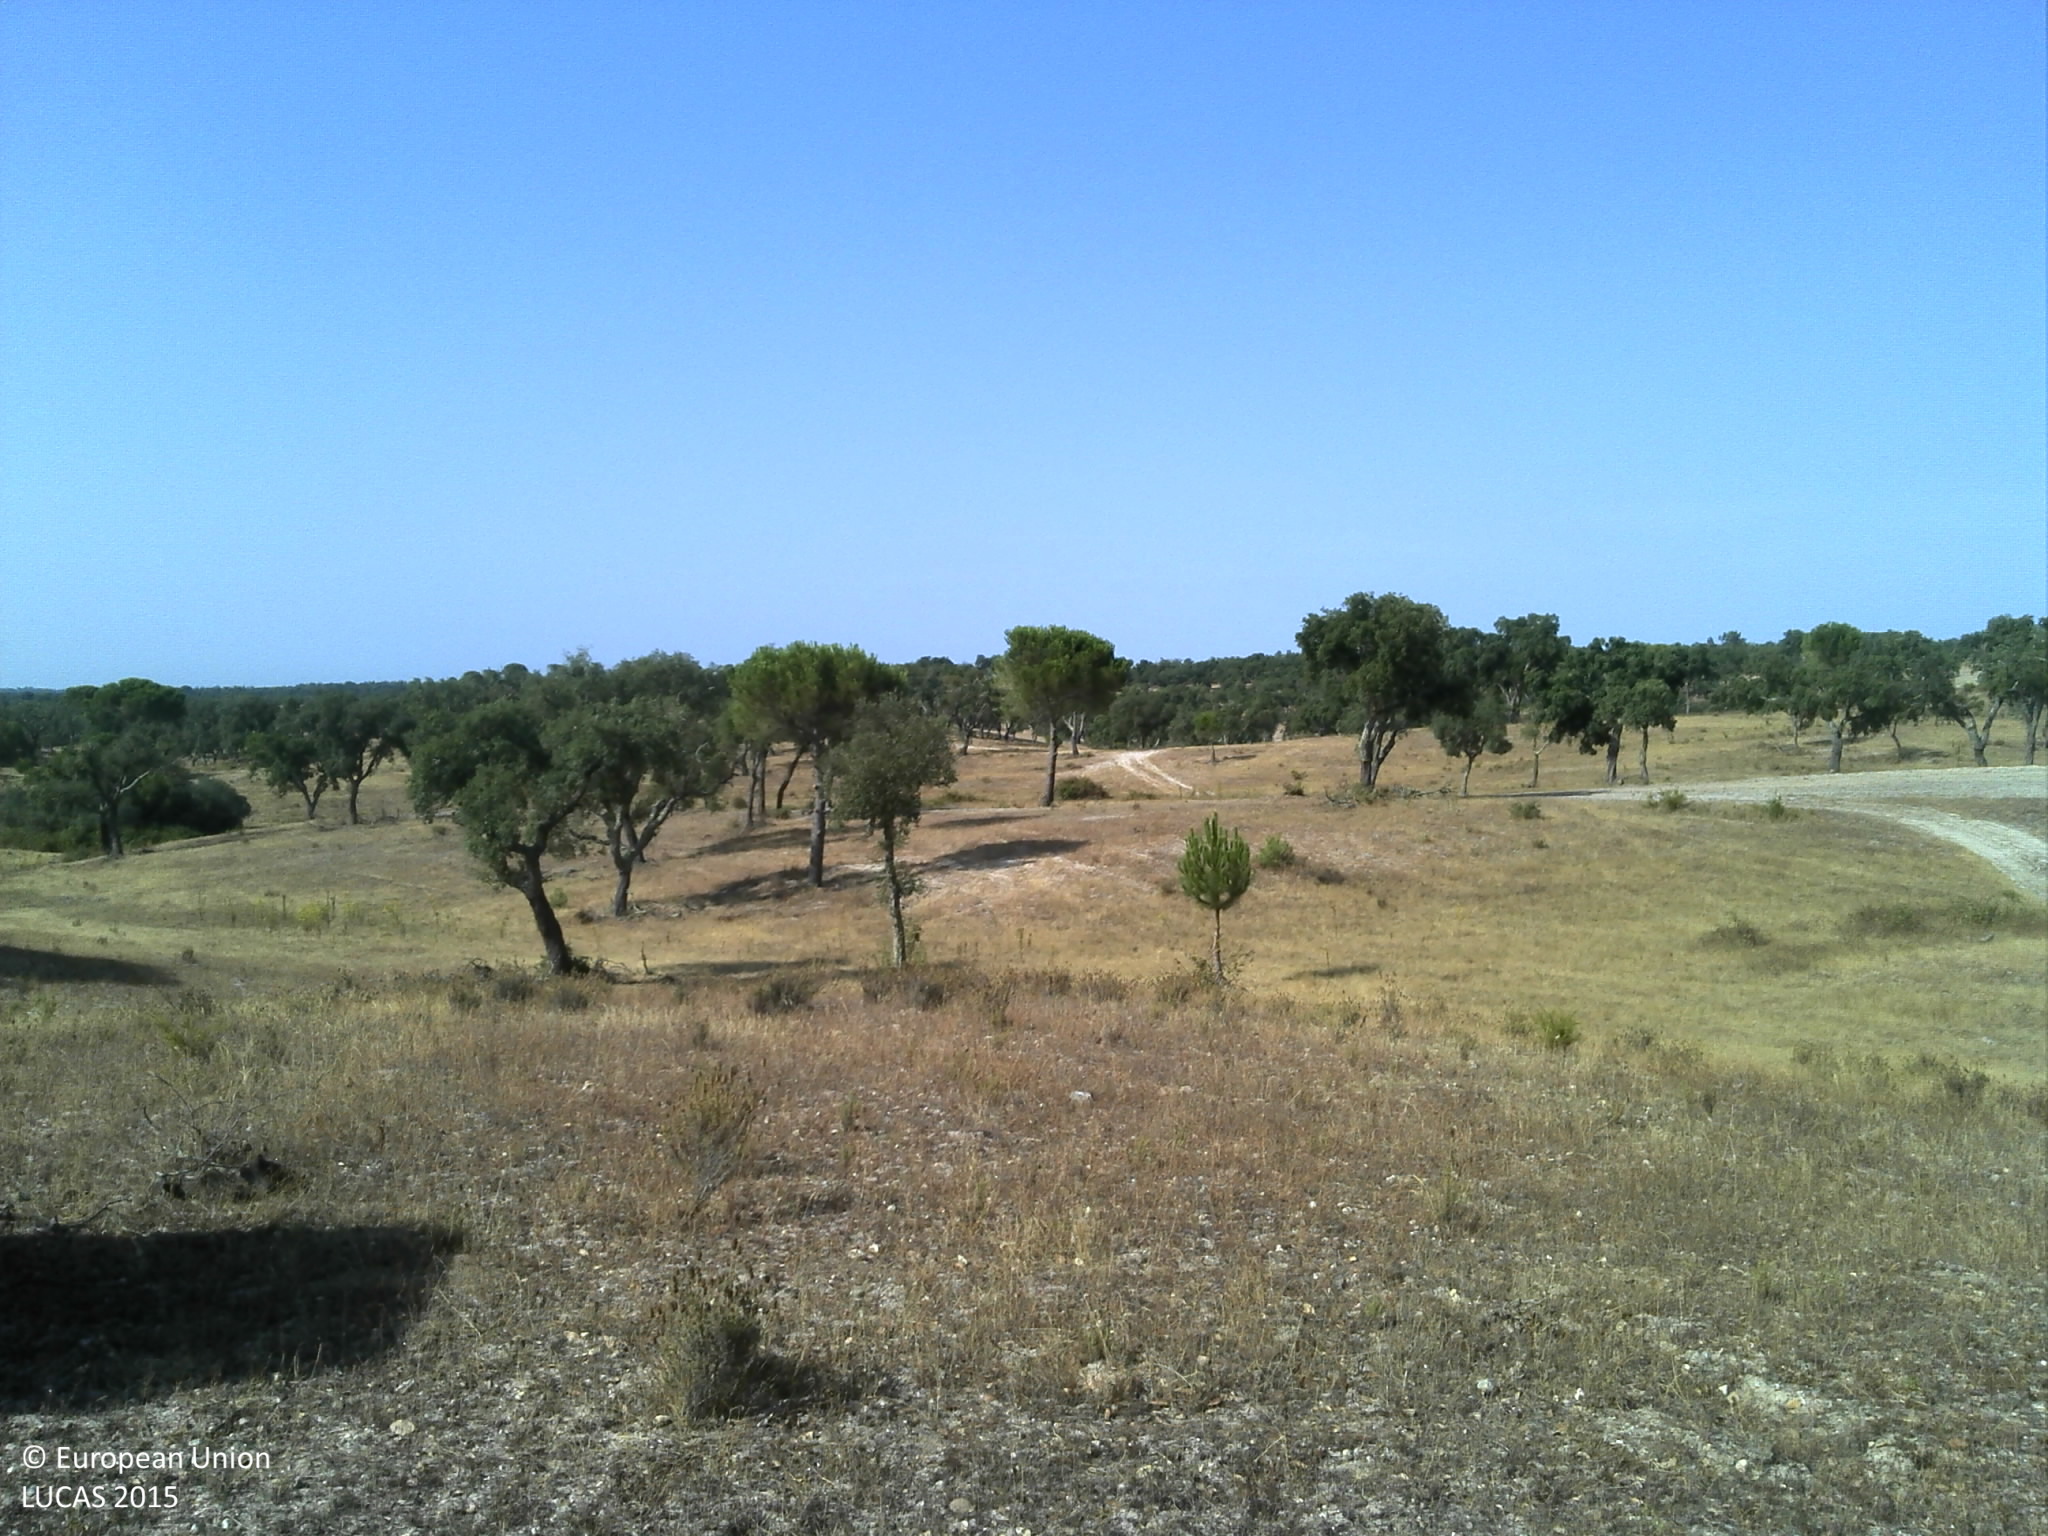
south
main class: Woodland
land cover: Broadleaved woodland
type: broadleaved evergreen forest
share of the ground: 25 - 50 %
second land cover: Grassland without tree/shrub cover
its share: 25 - 50 %
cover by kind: herbaceous plants 40 %, broadleaved forest trees 30 %, unconsolidated bare surface 30 %
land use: Forestry
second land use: Agriculture (excluding fallow land and kitchen gardens)
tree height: > 5 m
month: July
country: PT
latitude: 39.1170
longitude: -8.3228
